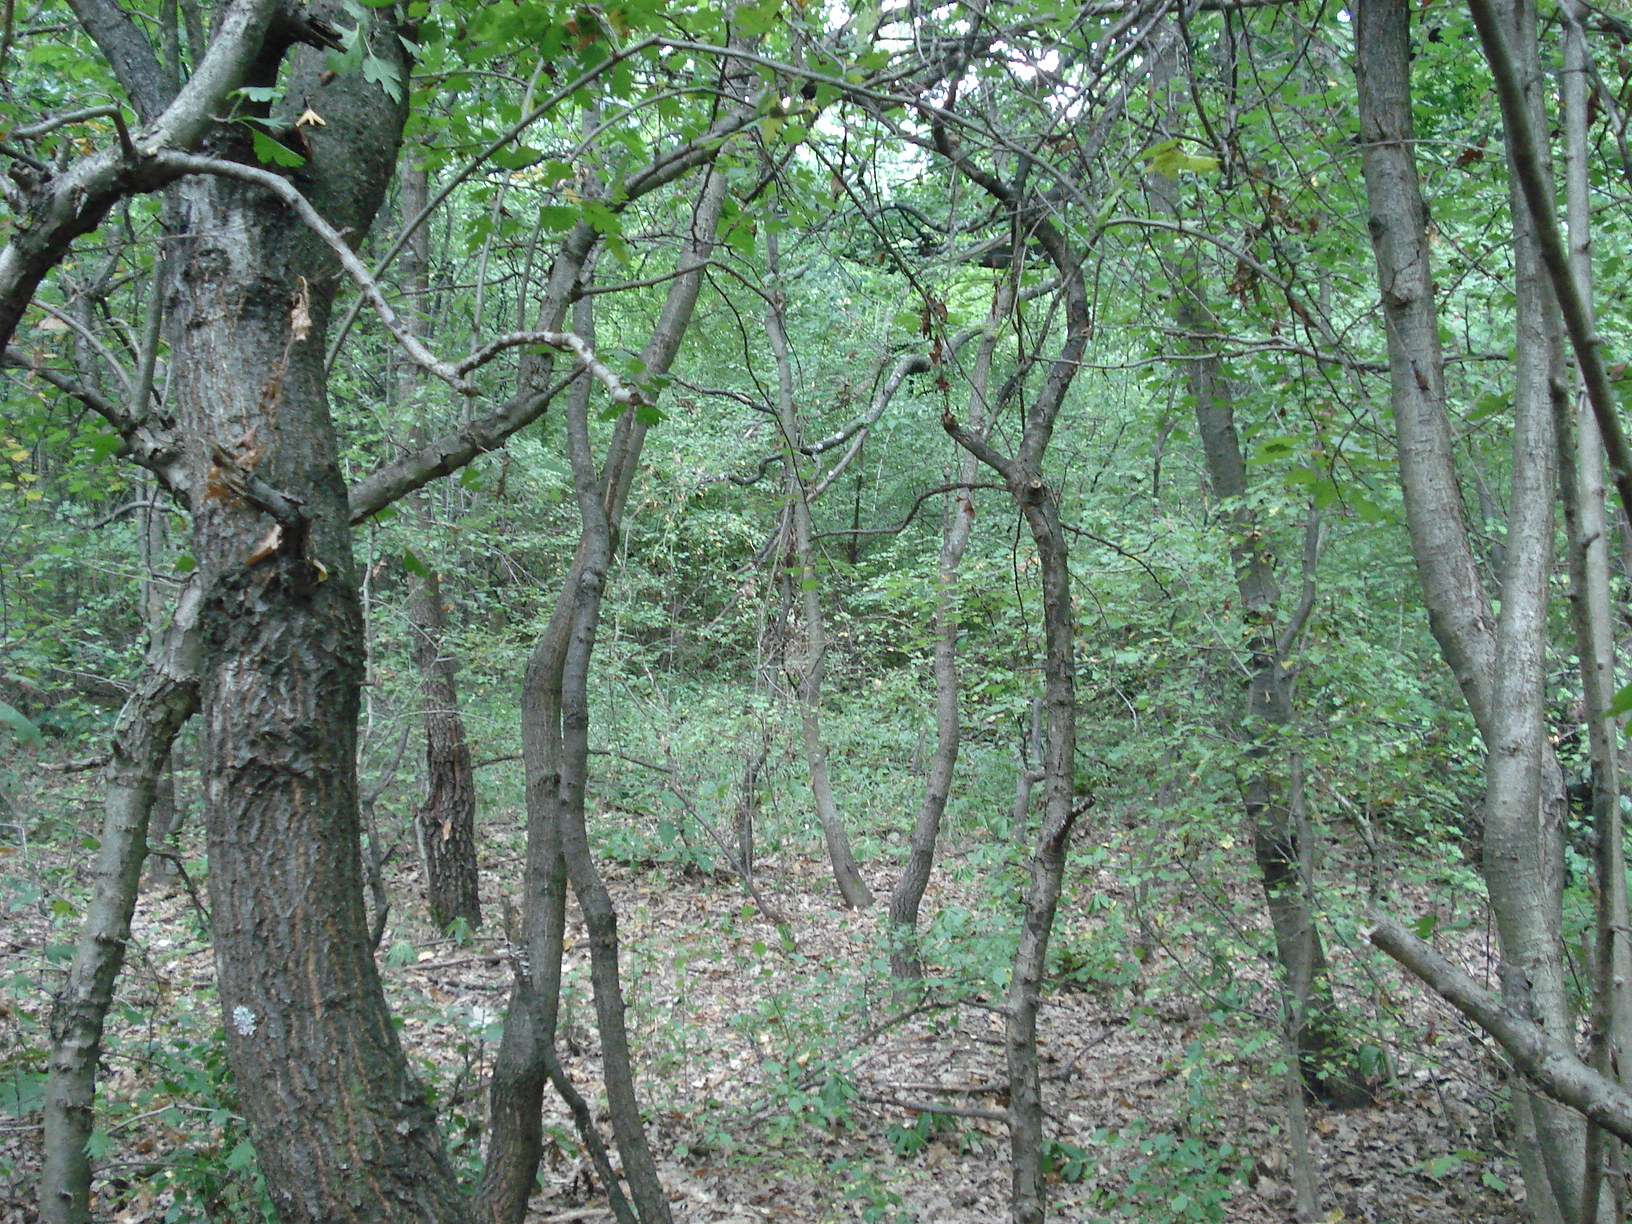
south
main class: Woodland
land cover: Broadleaved woodland
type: mesophytic deciduous forest
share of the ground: > 75 %
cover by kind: broadleaved forest trees 85 %, herbaceous plants 10 %, shrubs 5 %
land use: Forestry
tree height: > 5 m
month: September
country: BG
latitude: 43.0456
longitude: 25.7583
